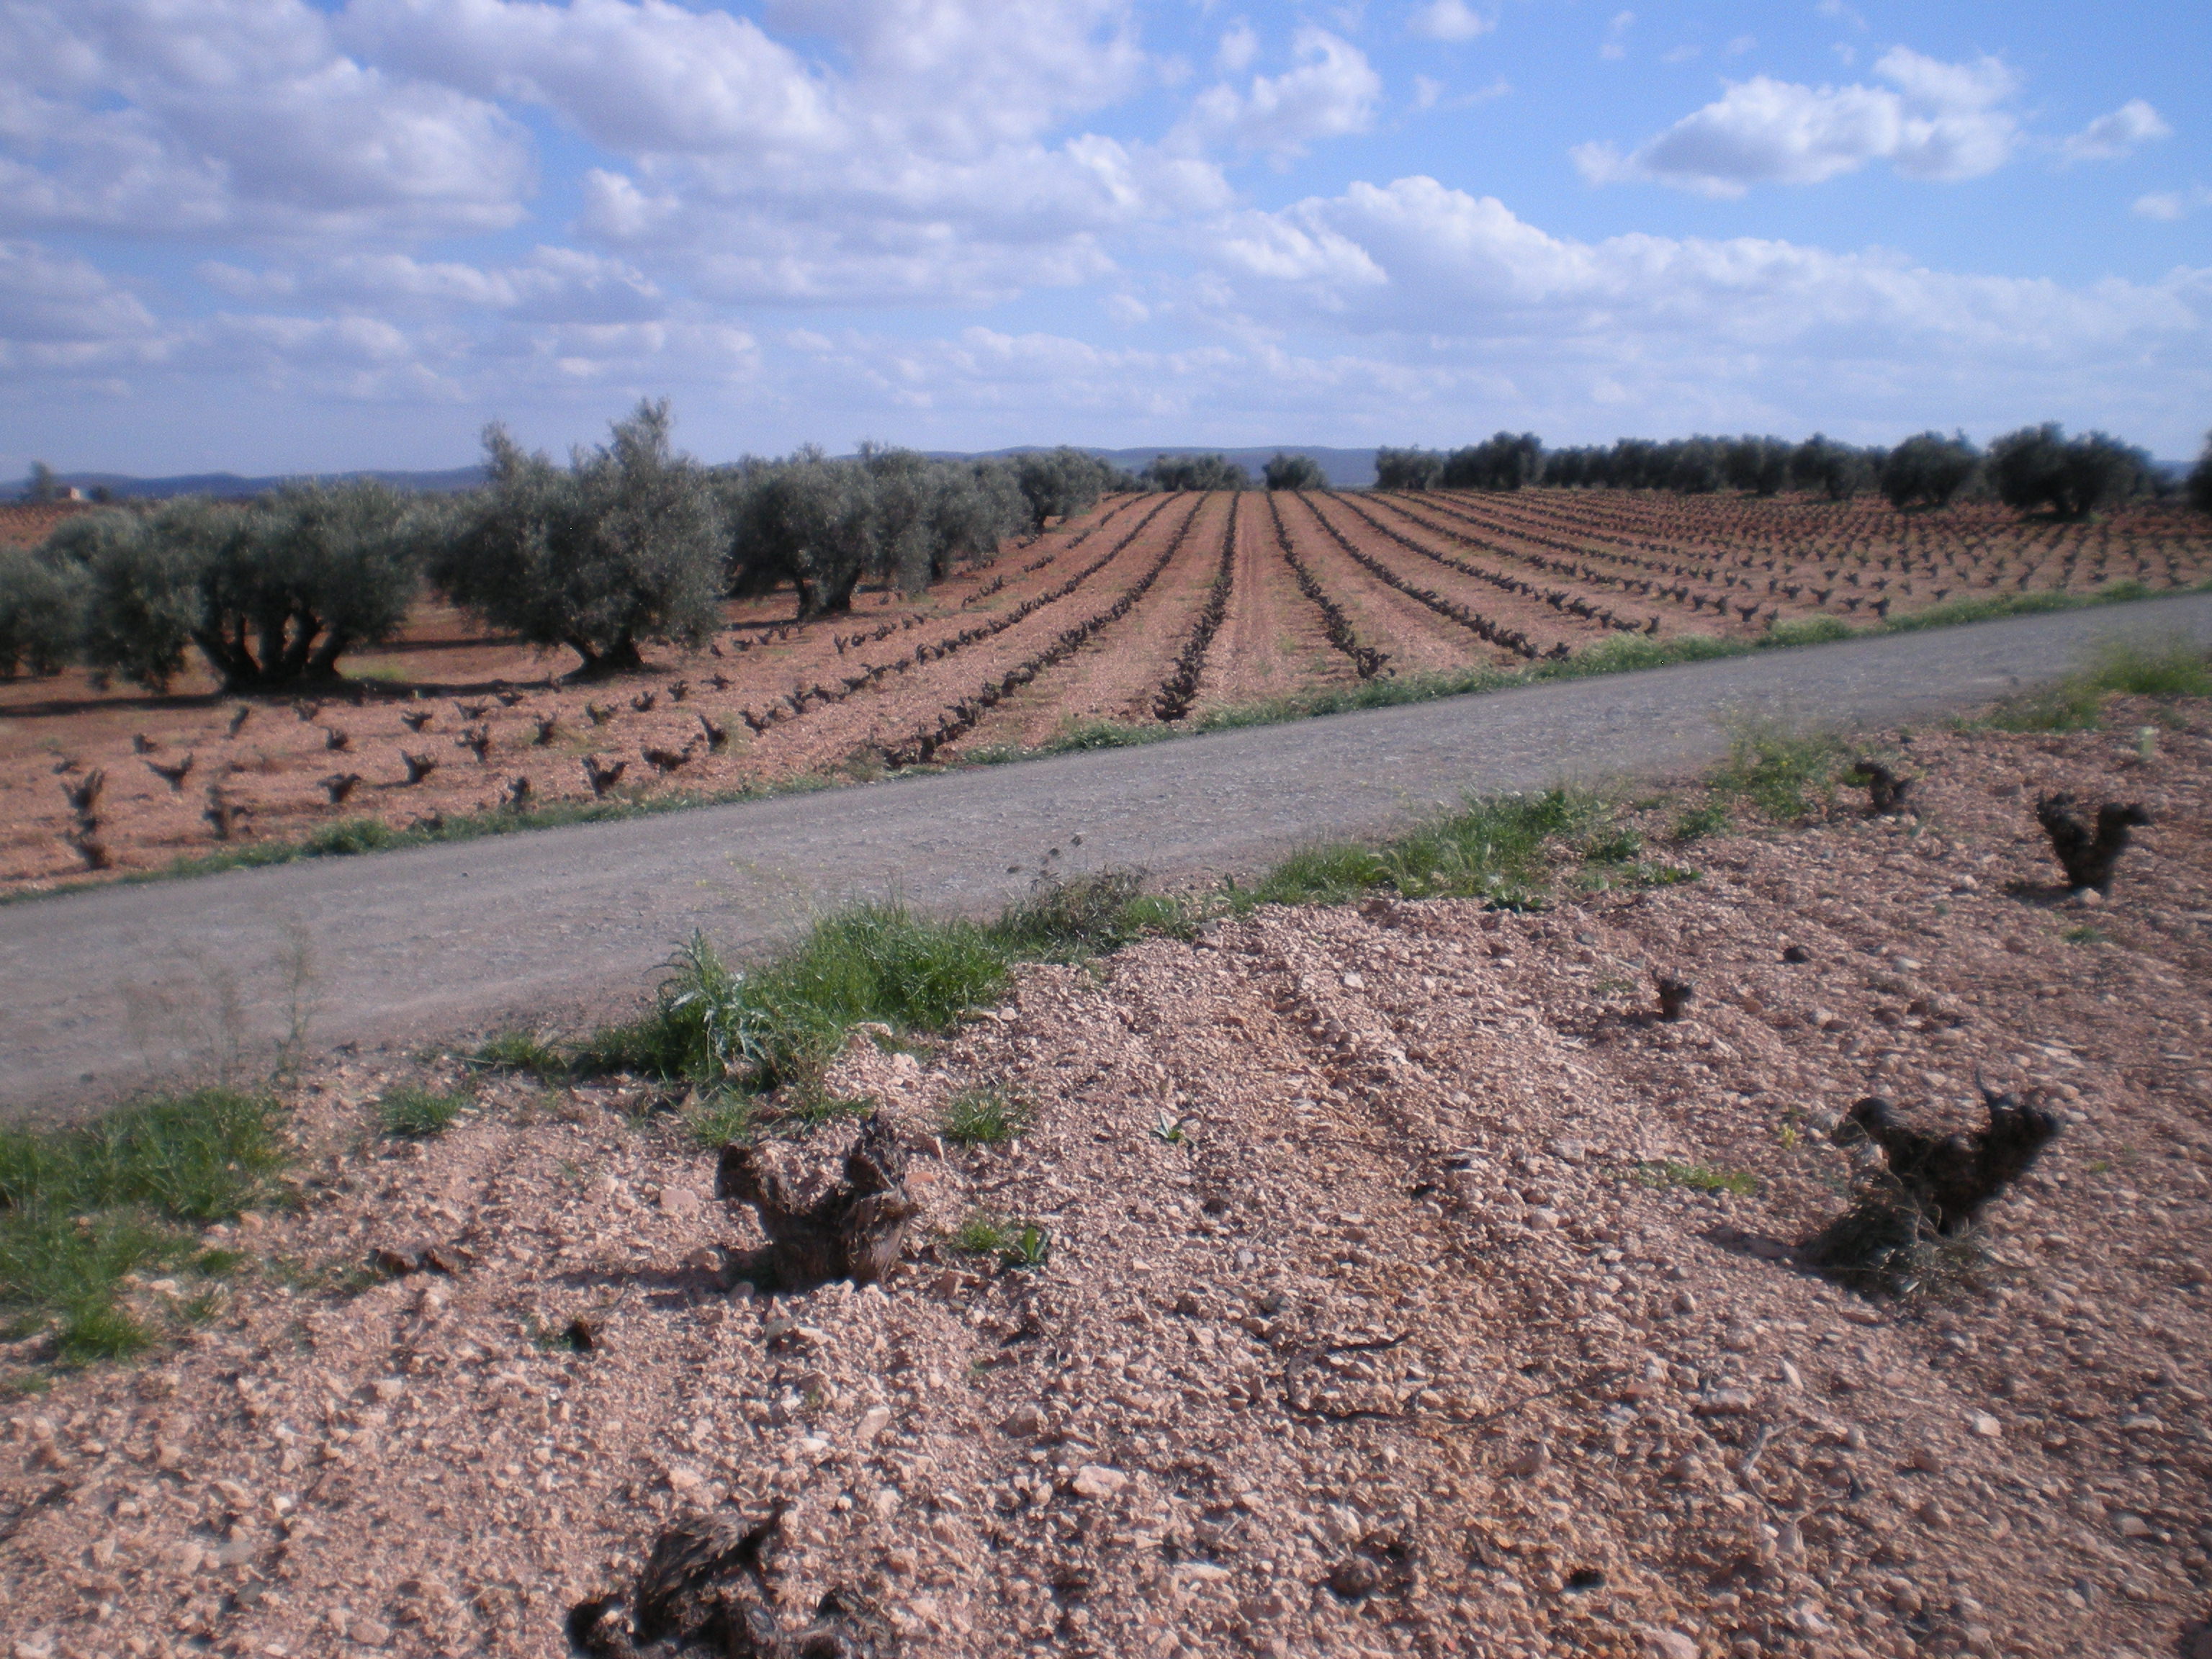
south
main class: Cropland
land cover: Vineyards
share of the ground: < 10 %
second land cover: Other bare soil
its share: > 75 %
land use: Agriculture (excluding fallow land and kitchen gardens)
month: April
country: ES
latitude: 38.8215
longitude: -3.5936
